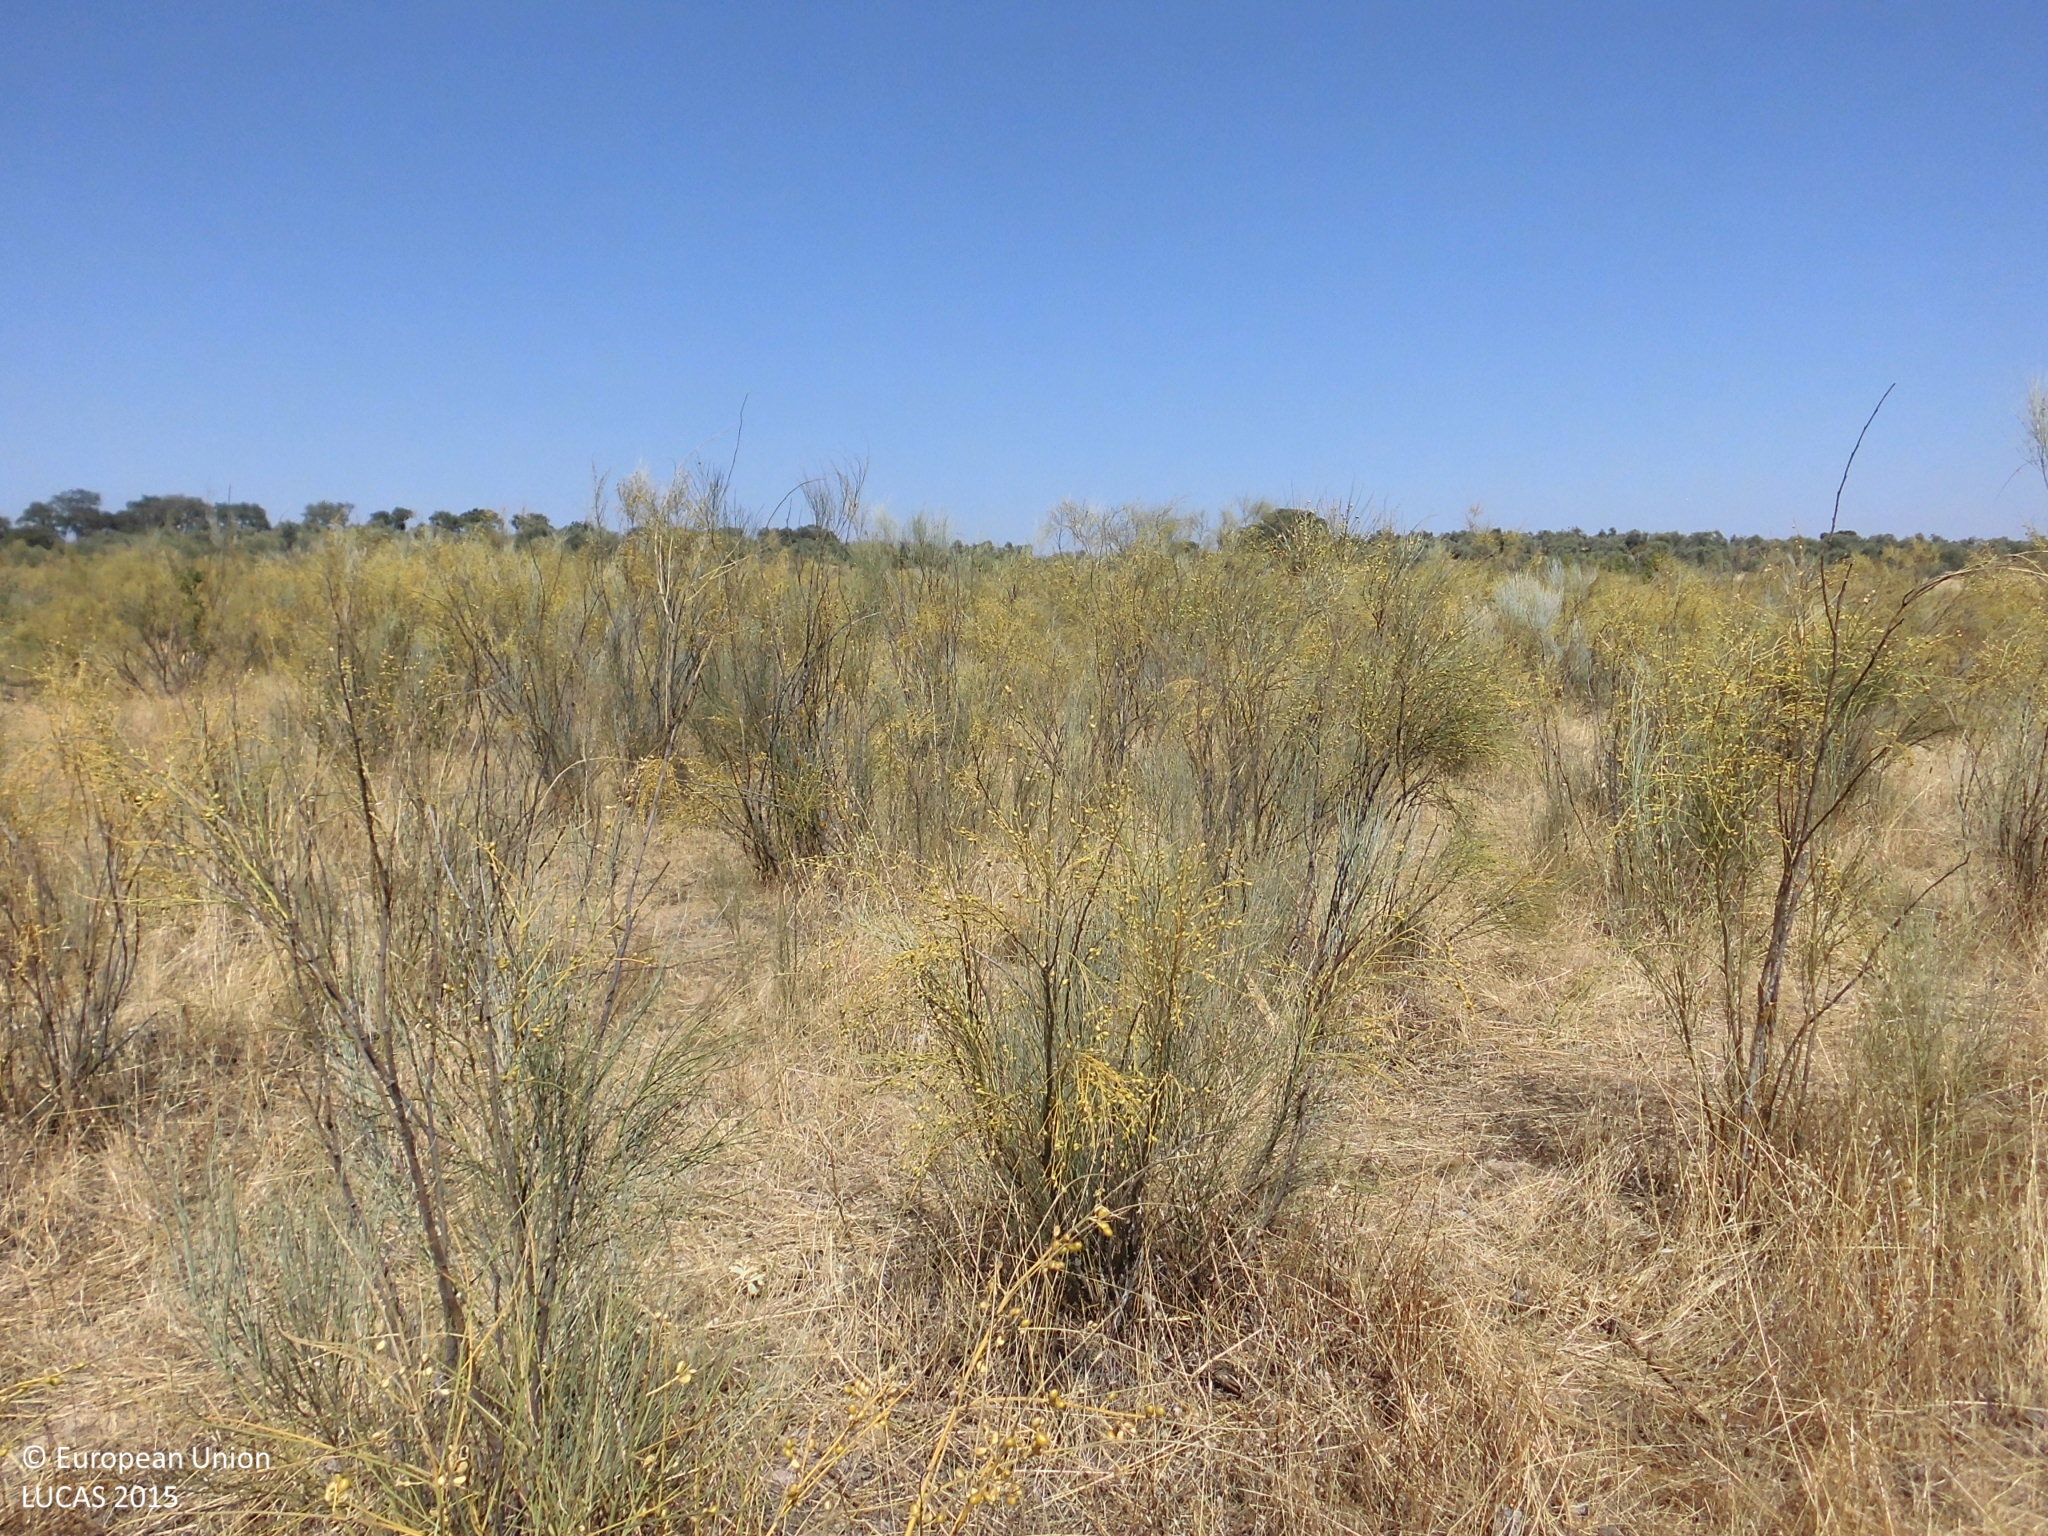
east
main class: Shrubland
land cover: Shrubland without tree cover
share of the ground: 50 - 75 %
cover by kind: shrubs 60 %, herbaceous plants 40 %
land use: Agriculture (excluding fallow land and kitchen gardens)
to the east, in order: Shrubland without tree cover; Dry stone walls; Grassland with sparse tree/shrub cover; Tracks; Grassland with sparse tree/shrub cover; Dry stone walls; Olive groves
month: July
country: ES
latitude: 40.0520
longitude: -6.5271
